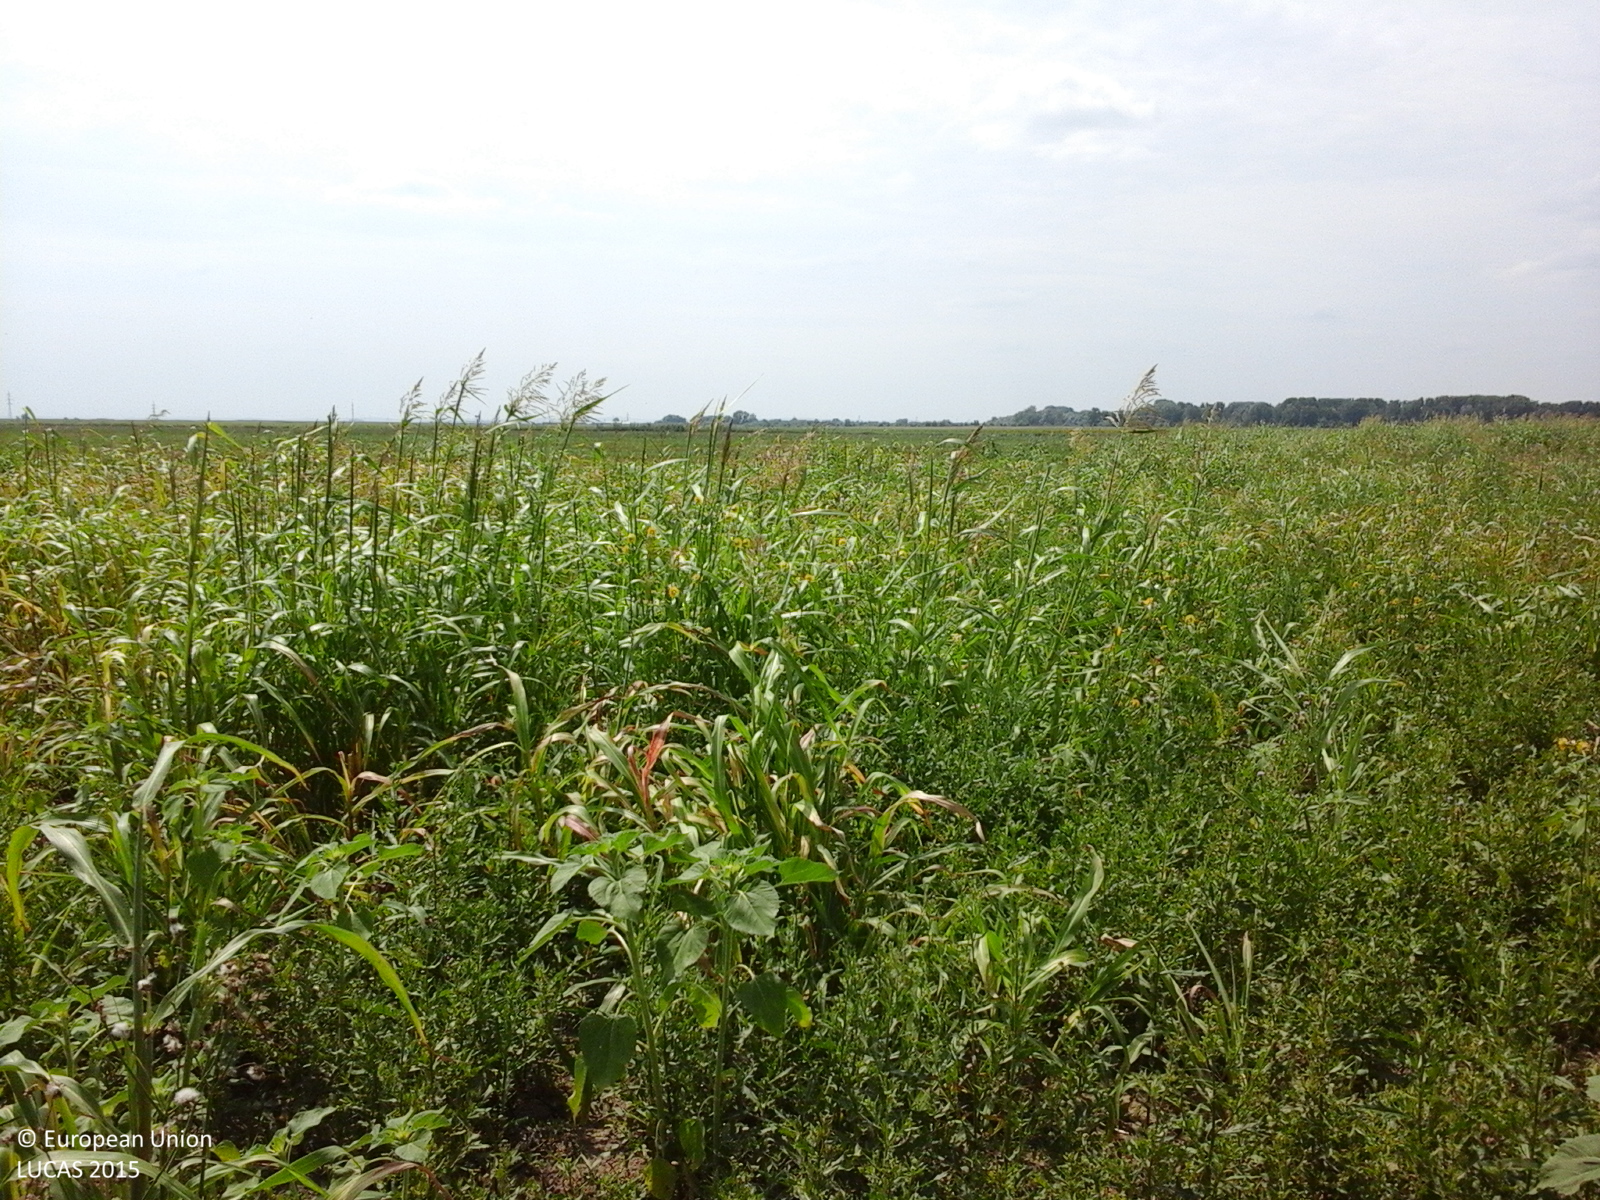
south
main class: Grassland
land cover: Spontaneously vegetated surfaces
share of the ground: > 75 %
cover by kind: herbaceous plants 100 %
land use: Fallow land
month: August
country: RO
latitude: 45.3280
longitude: 28.8089
